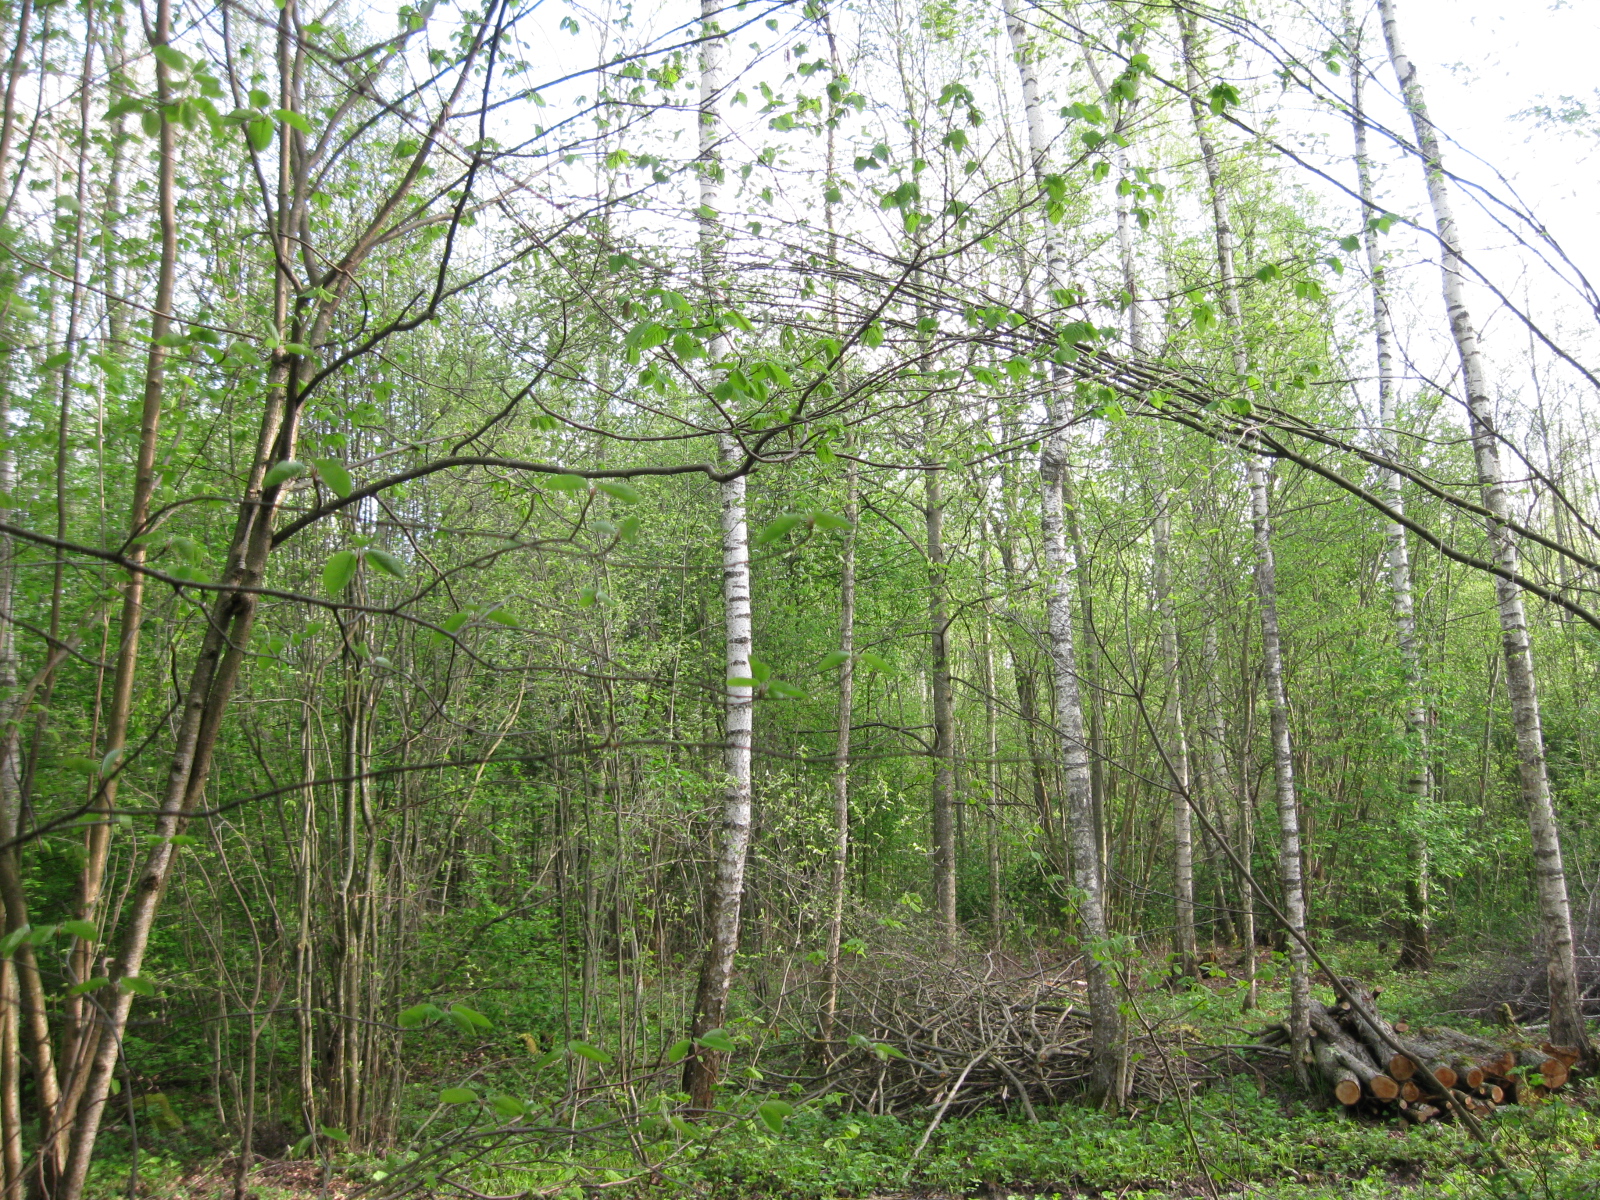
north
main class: Woodland
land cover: Broadleaved woodland
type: non-riverine alder, birch or aspen forest
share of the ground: > 75 %
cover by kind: broadleaved forest trees 90 %, herbaceous plants 10 %
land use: Forestry
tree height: > 5 m
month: May
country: LT
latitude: 56.2397
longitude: 24.4727
